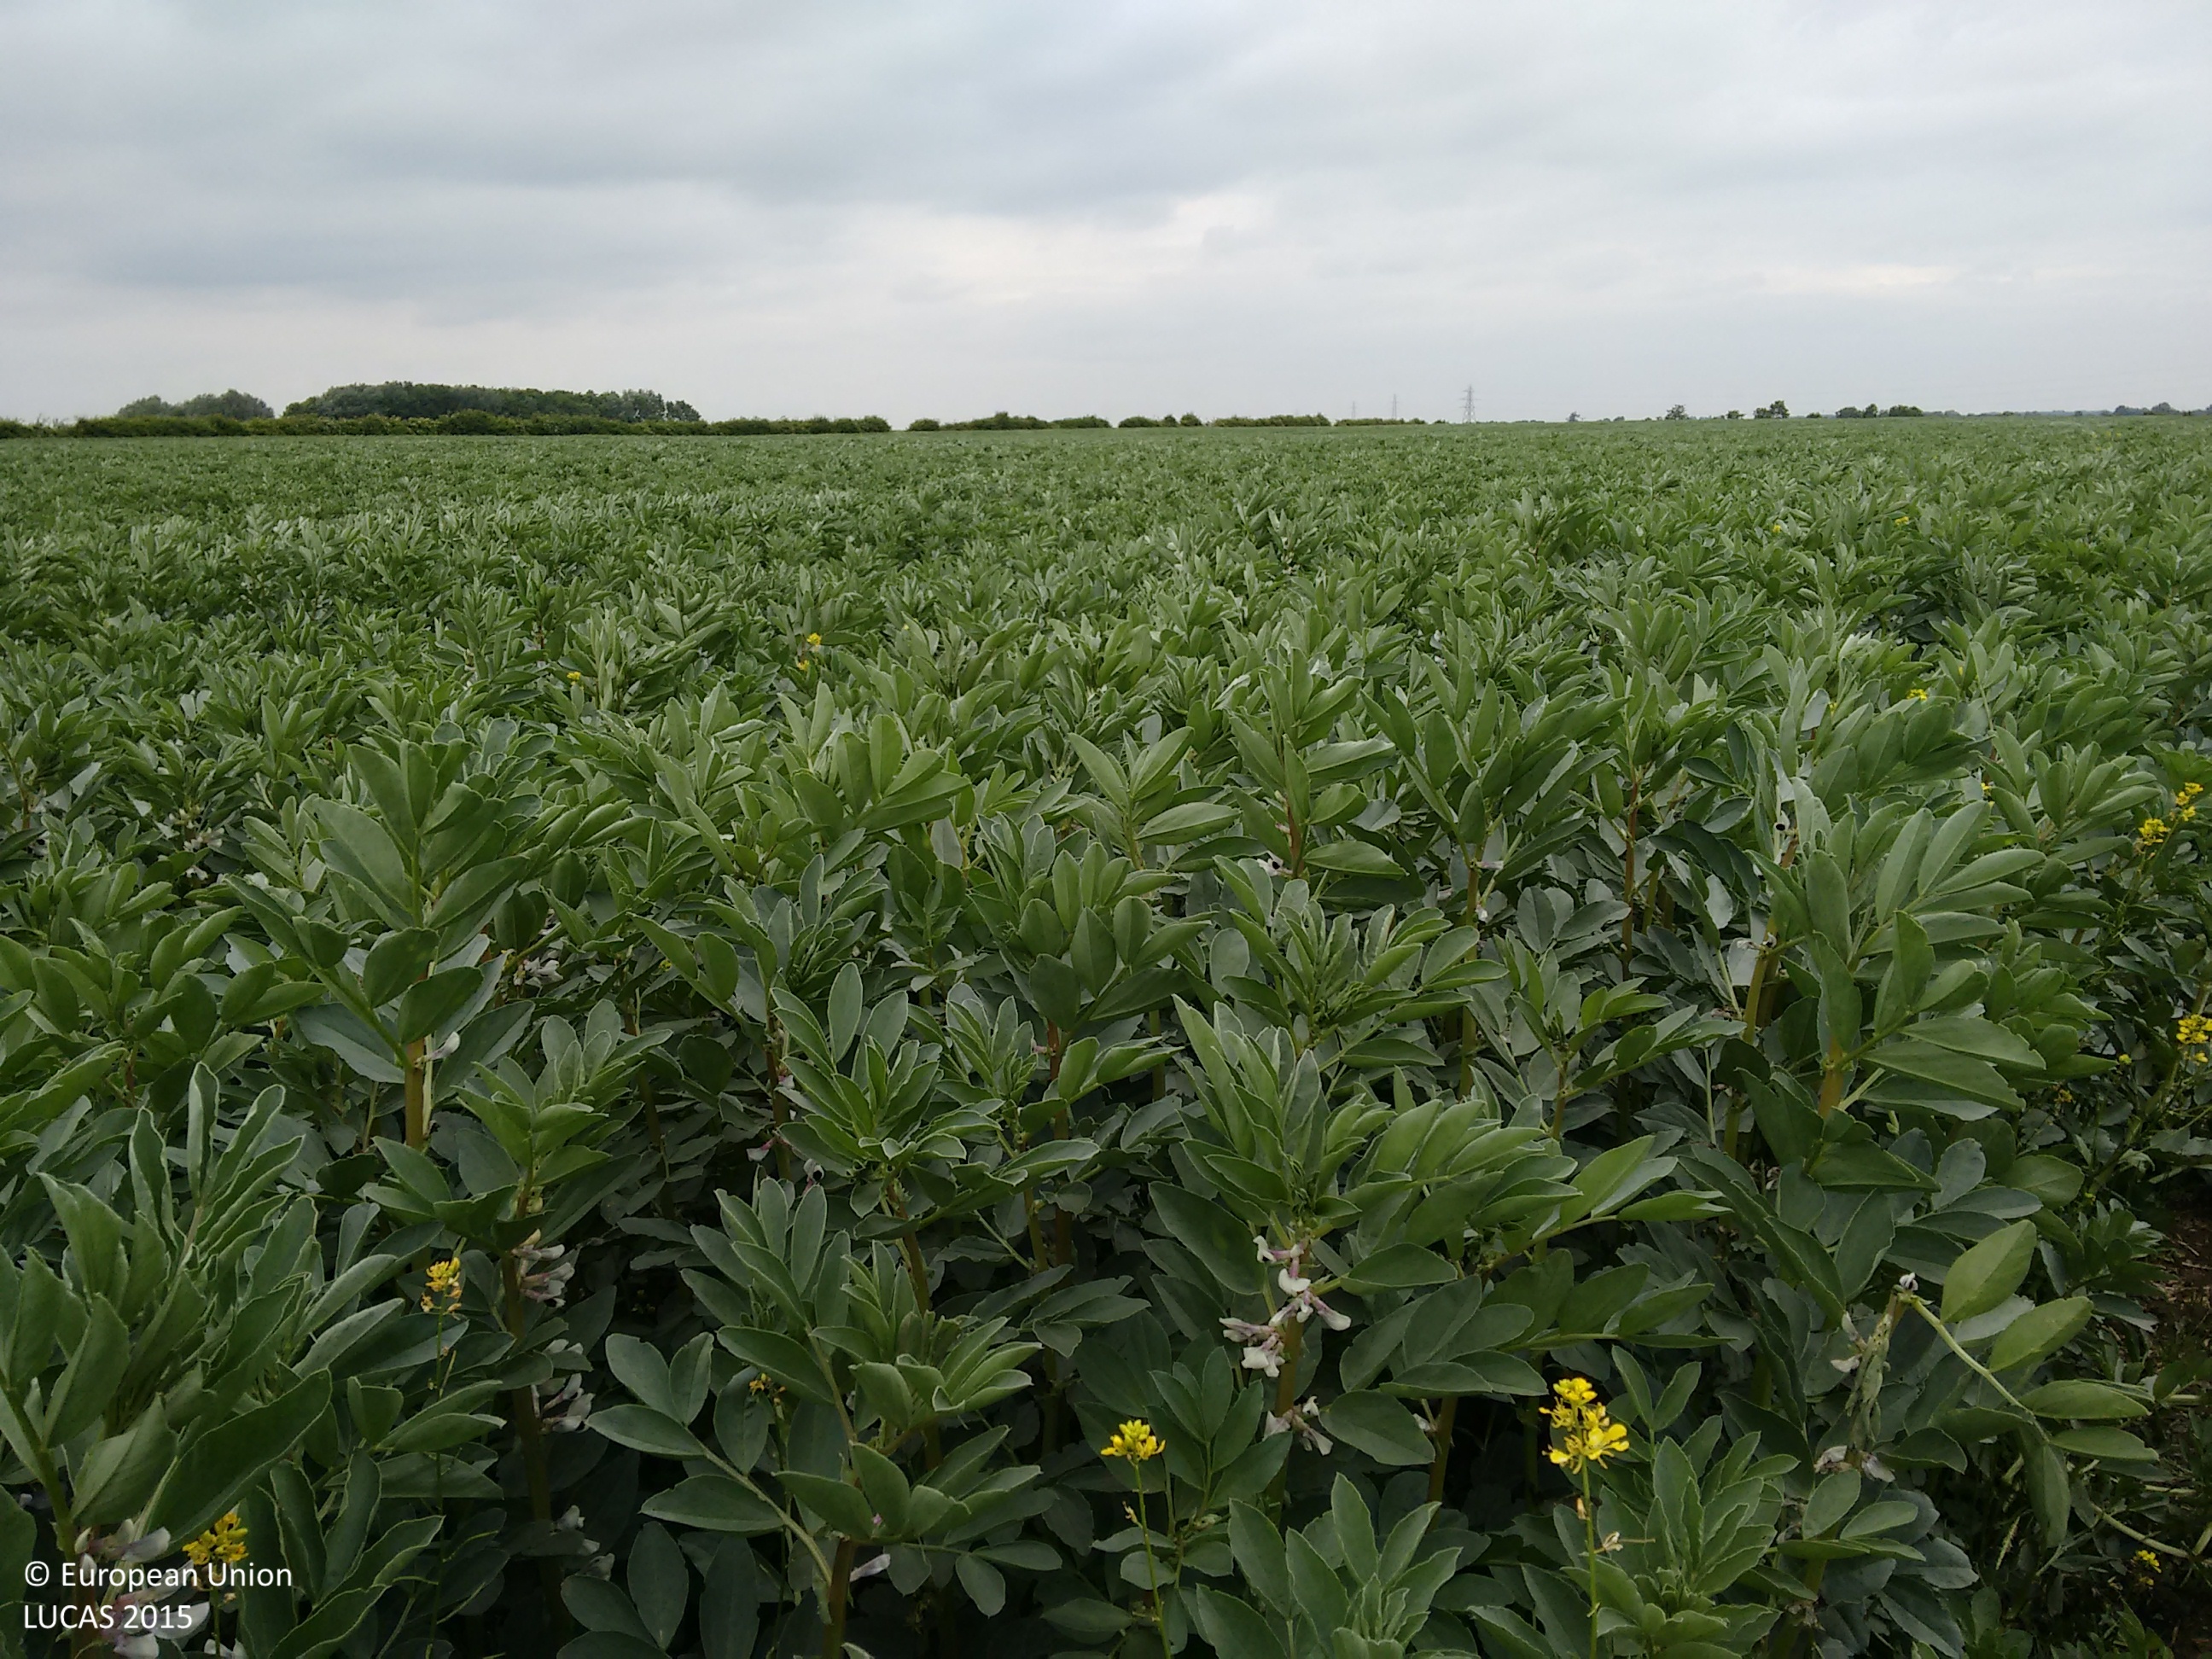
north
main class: Cropland
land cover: Dry pulses
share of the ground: > 75 %
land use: Agriculture (excluding fallow land and kitchen gardens)
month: June
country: GB
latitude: 52.9330
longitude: -0.8280
